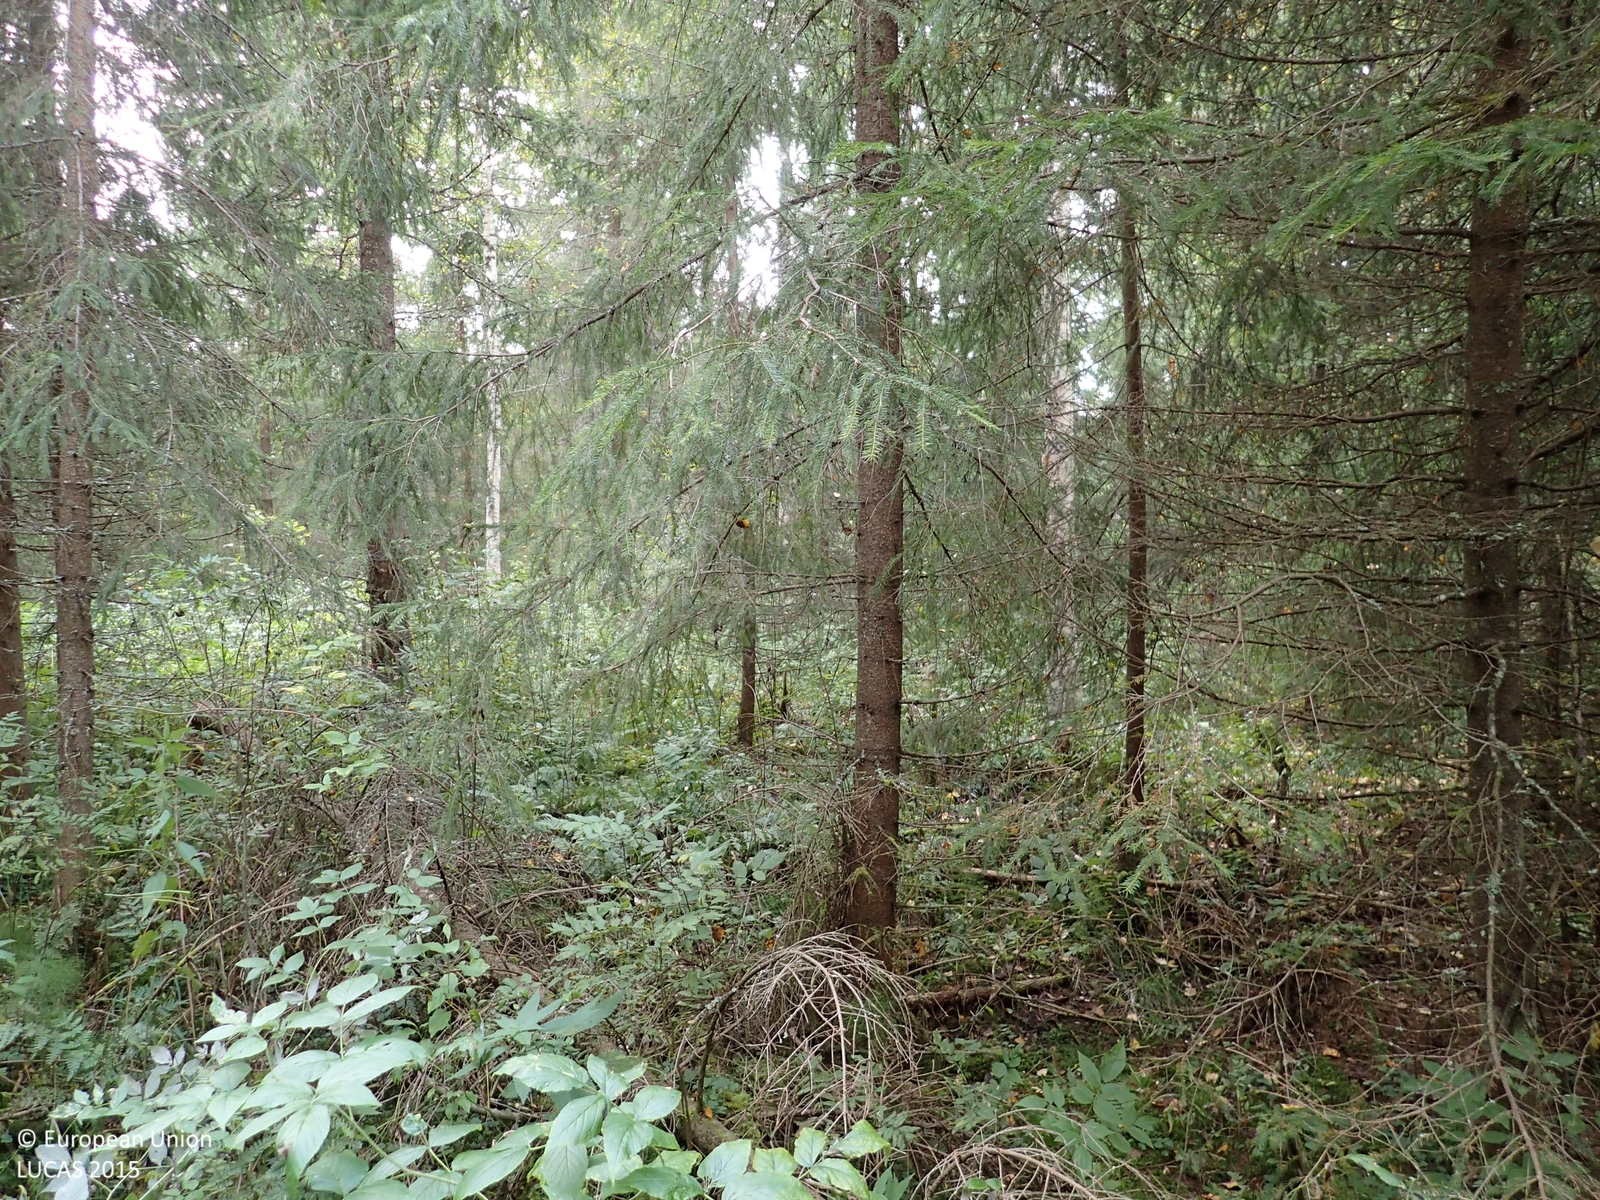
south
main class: Woodland
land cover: Spruce dominated mixed woodland
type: boreal forest
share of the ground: > 75 %
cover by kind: coniferous forest trees 55 %, broadleaved forest trees 20 %, herbaceous plants 20 %, lichens and mosses 5 %
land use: Forestry
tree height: > 5 m
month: September
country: FI
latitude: 62.9630
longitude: 25.8714
